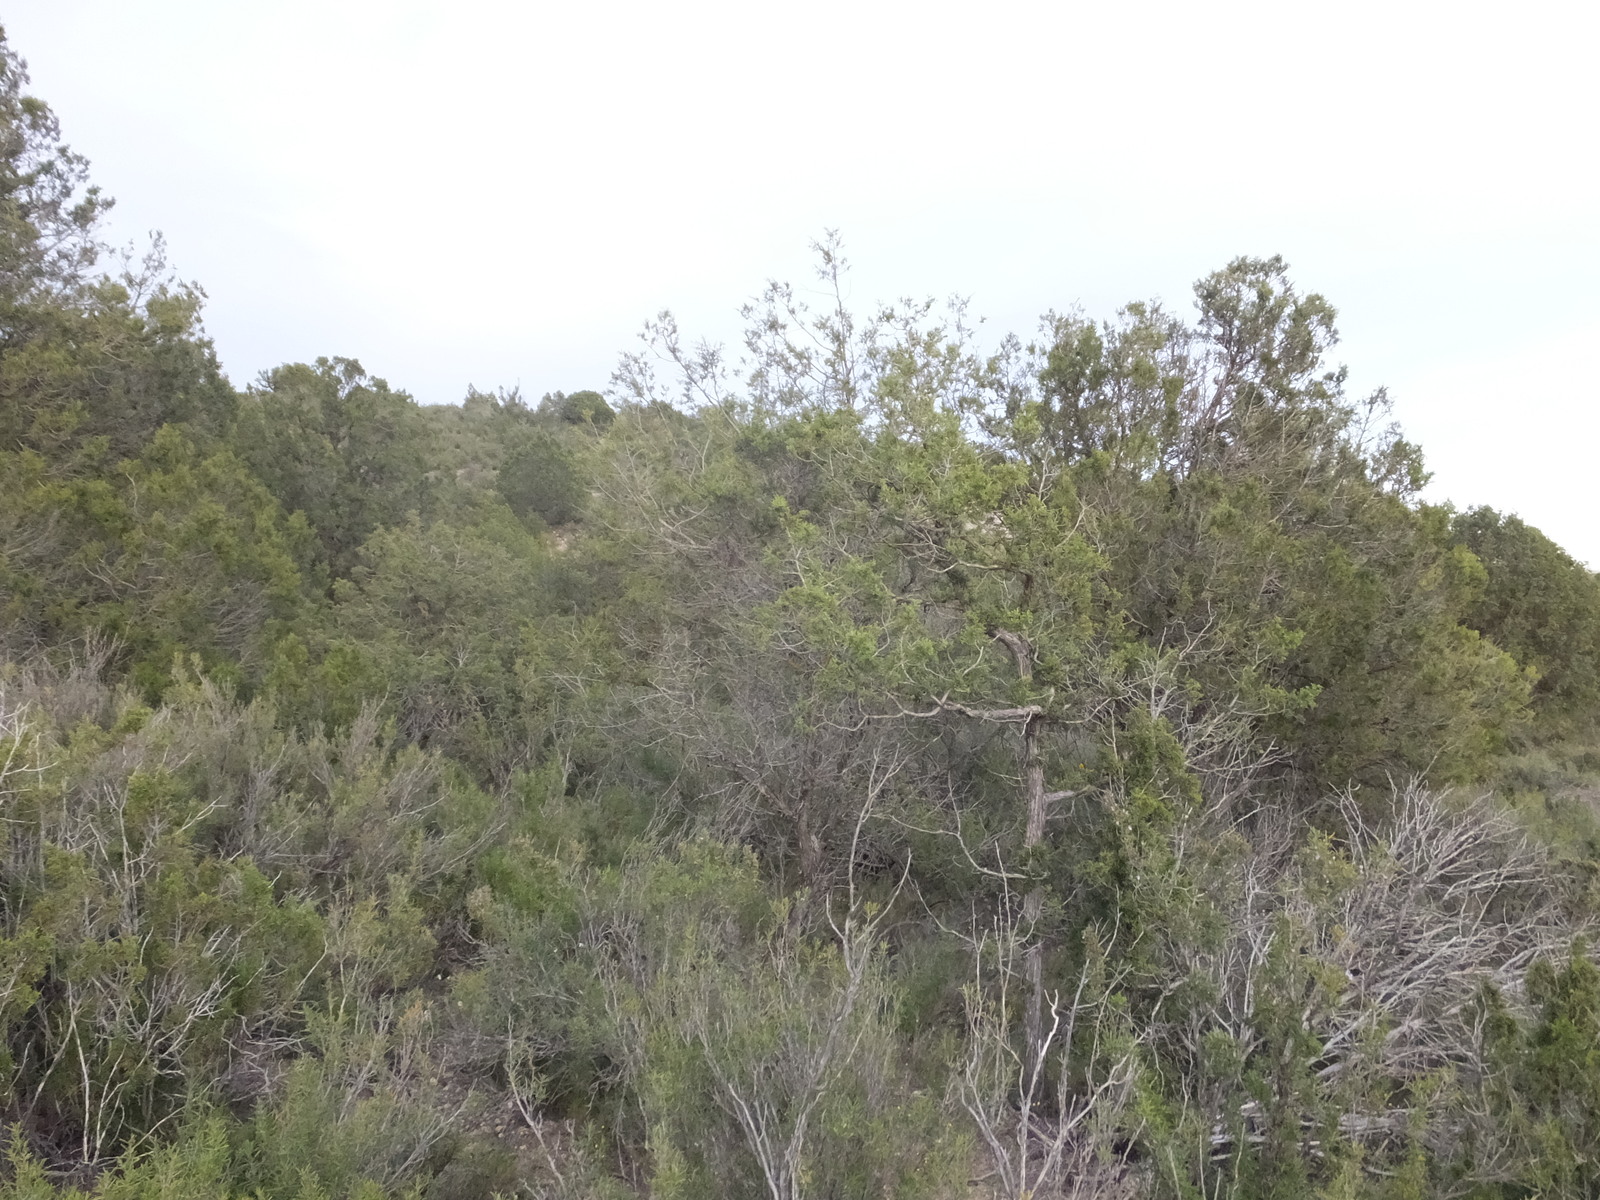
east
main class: Shrubland
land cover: Shrubland with sparse tree cover
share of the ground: > 75 %
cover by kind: shrubs 75 %, herbaceous plants 20 %, coniferous forest trees 5 %
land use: Semi-natural and natural areas not in use
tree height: > 5 m
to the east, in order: Shrubland with sparse tree cover; Other bare soil; Shrubland with sparse tree cover; Tracks; Shrubland with sparse tree cover
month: April
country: ES
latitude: 41.6715
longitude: -0.3115
